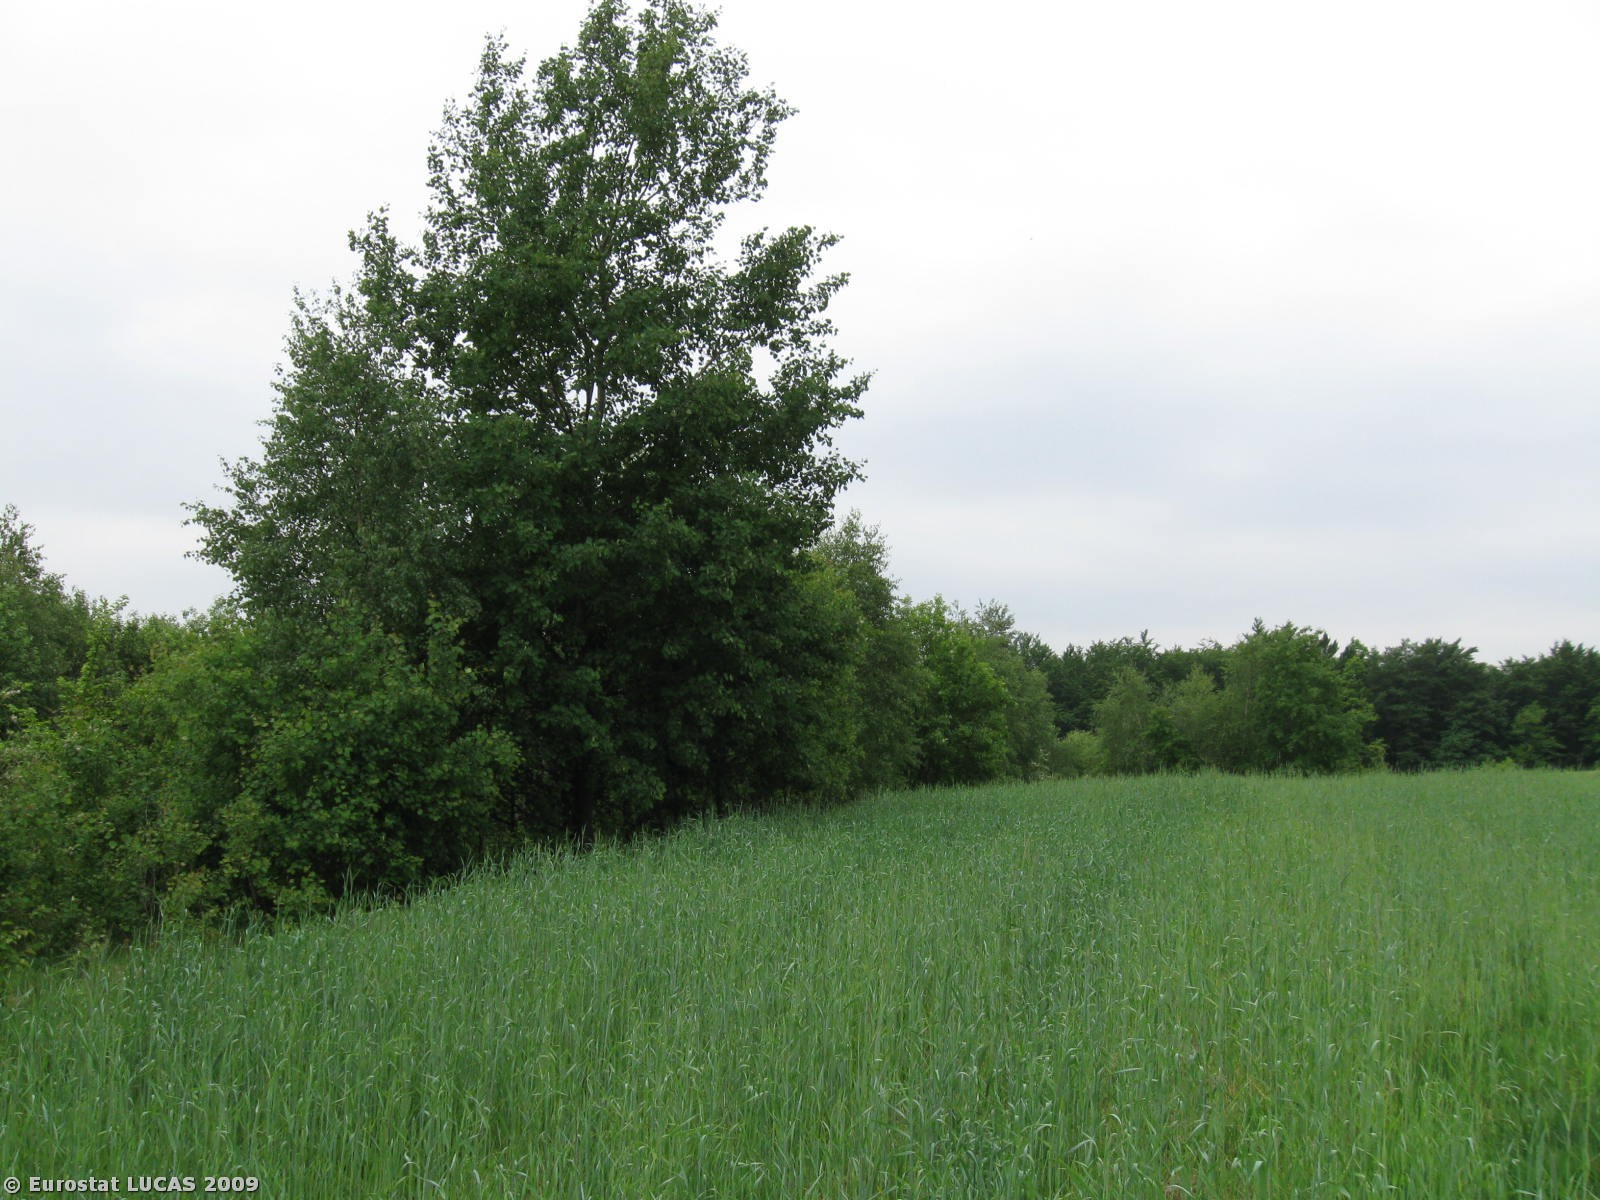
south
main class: Cropland
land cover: Rye
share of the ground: > 75 %
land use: Agriculture (excluding fallow land and kitchen gardens)
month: May
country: PL
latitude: 50.9697
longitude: 20.4762
